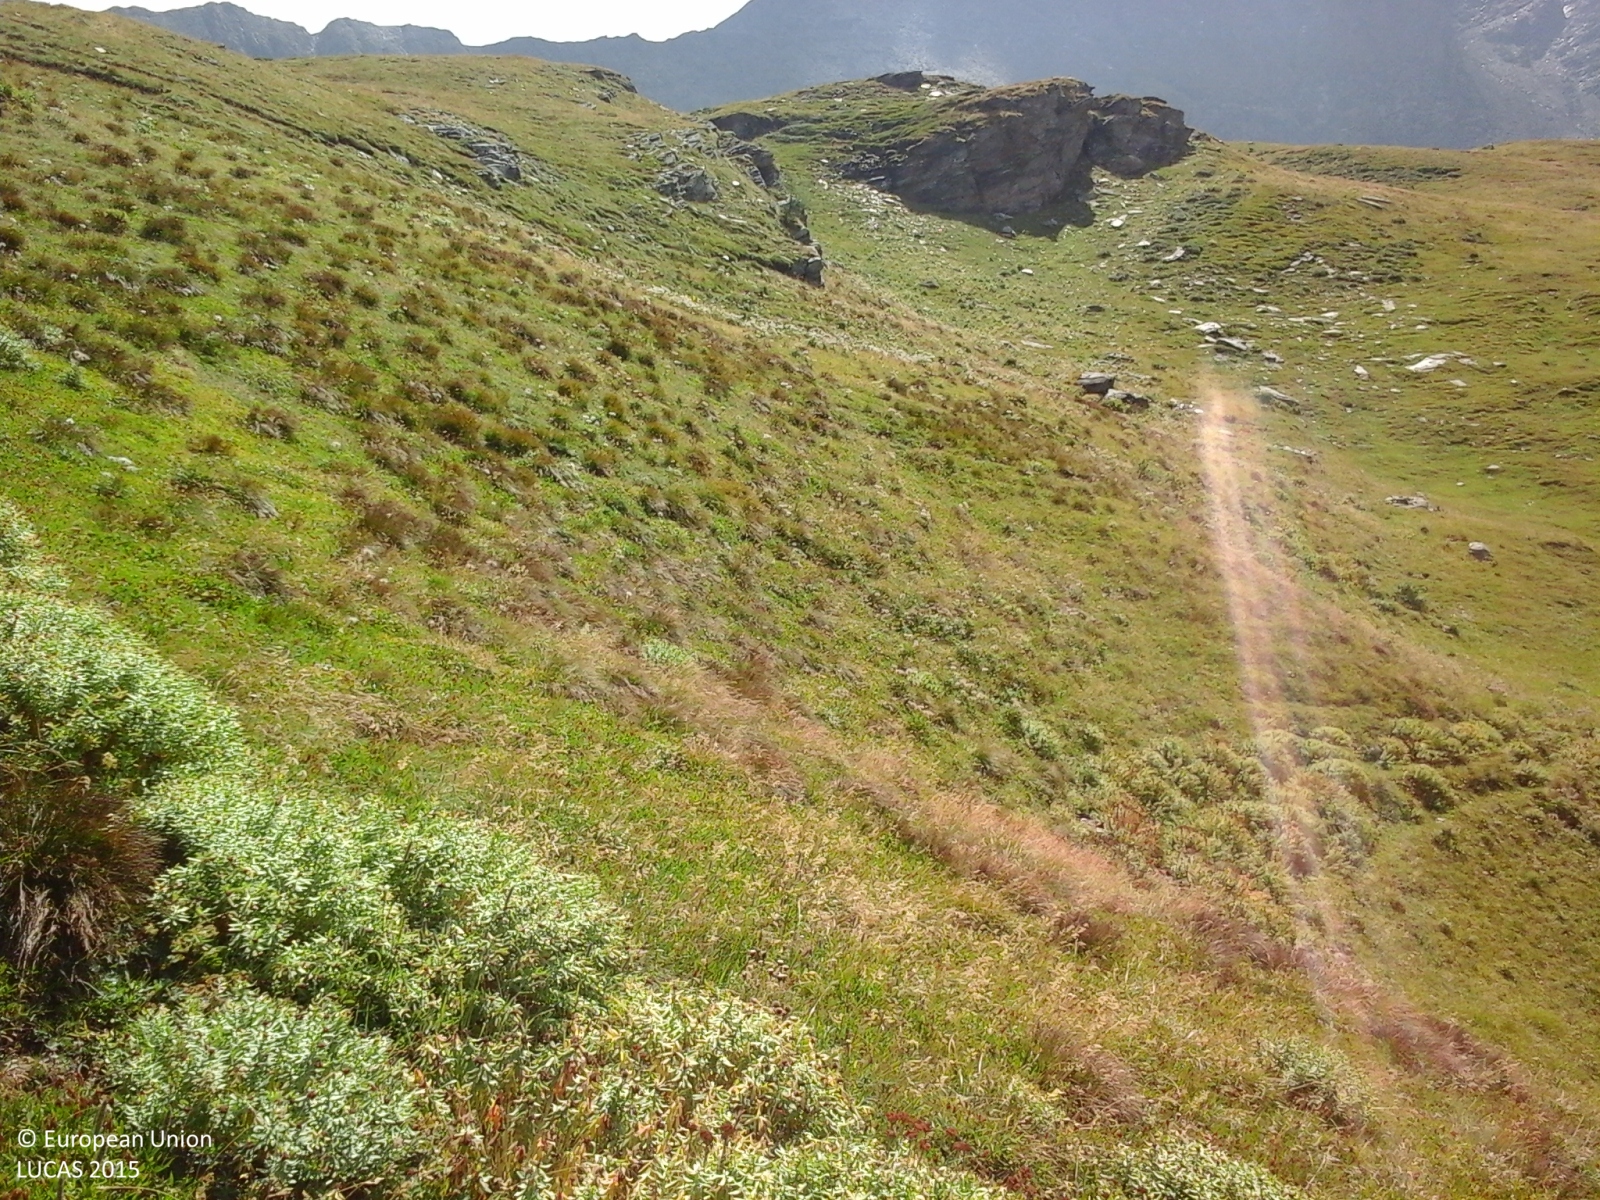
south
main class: Grassland
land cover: Grassland without tree/shrub cover
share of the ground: > 75 %
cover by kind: herbaceous plants 100 %
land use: Agriculture (excluding fallow land and kitchen gardens)
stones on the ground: < 10 %
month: August
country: IT
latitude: 45.6023
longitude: 7.5548
